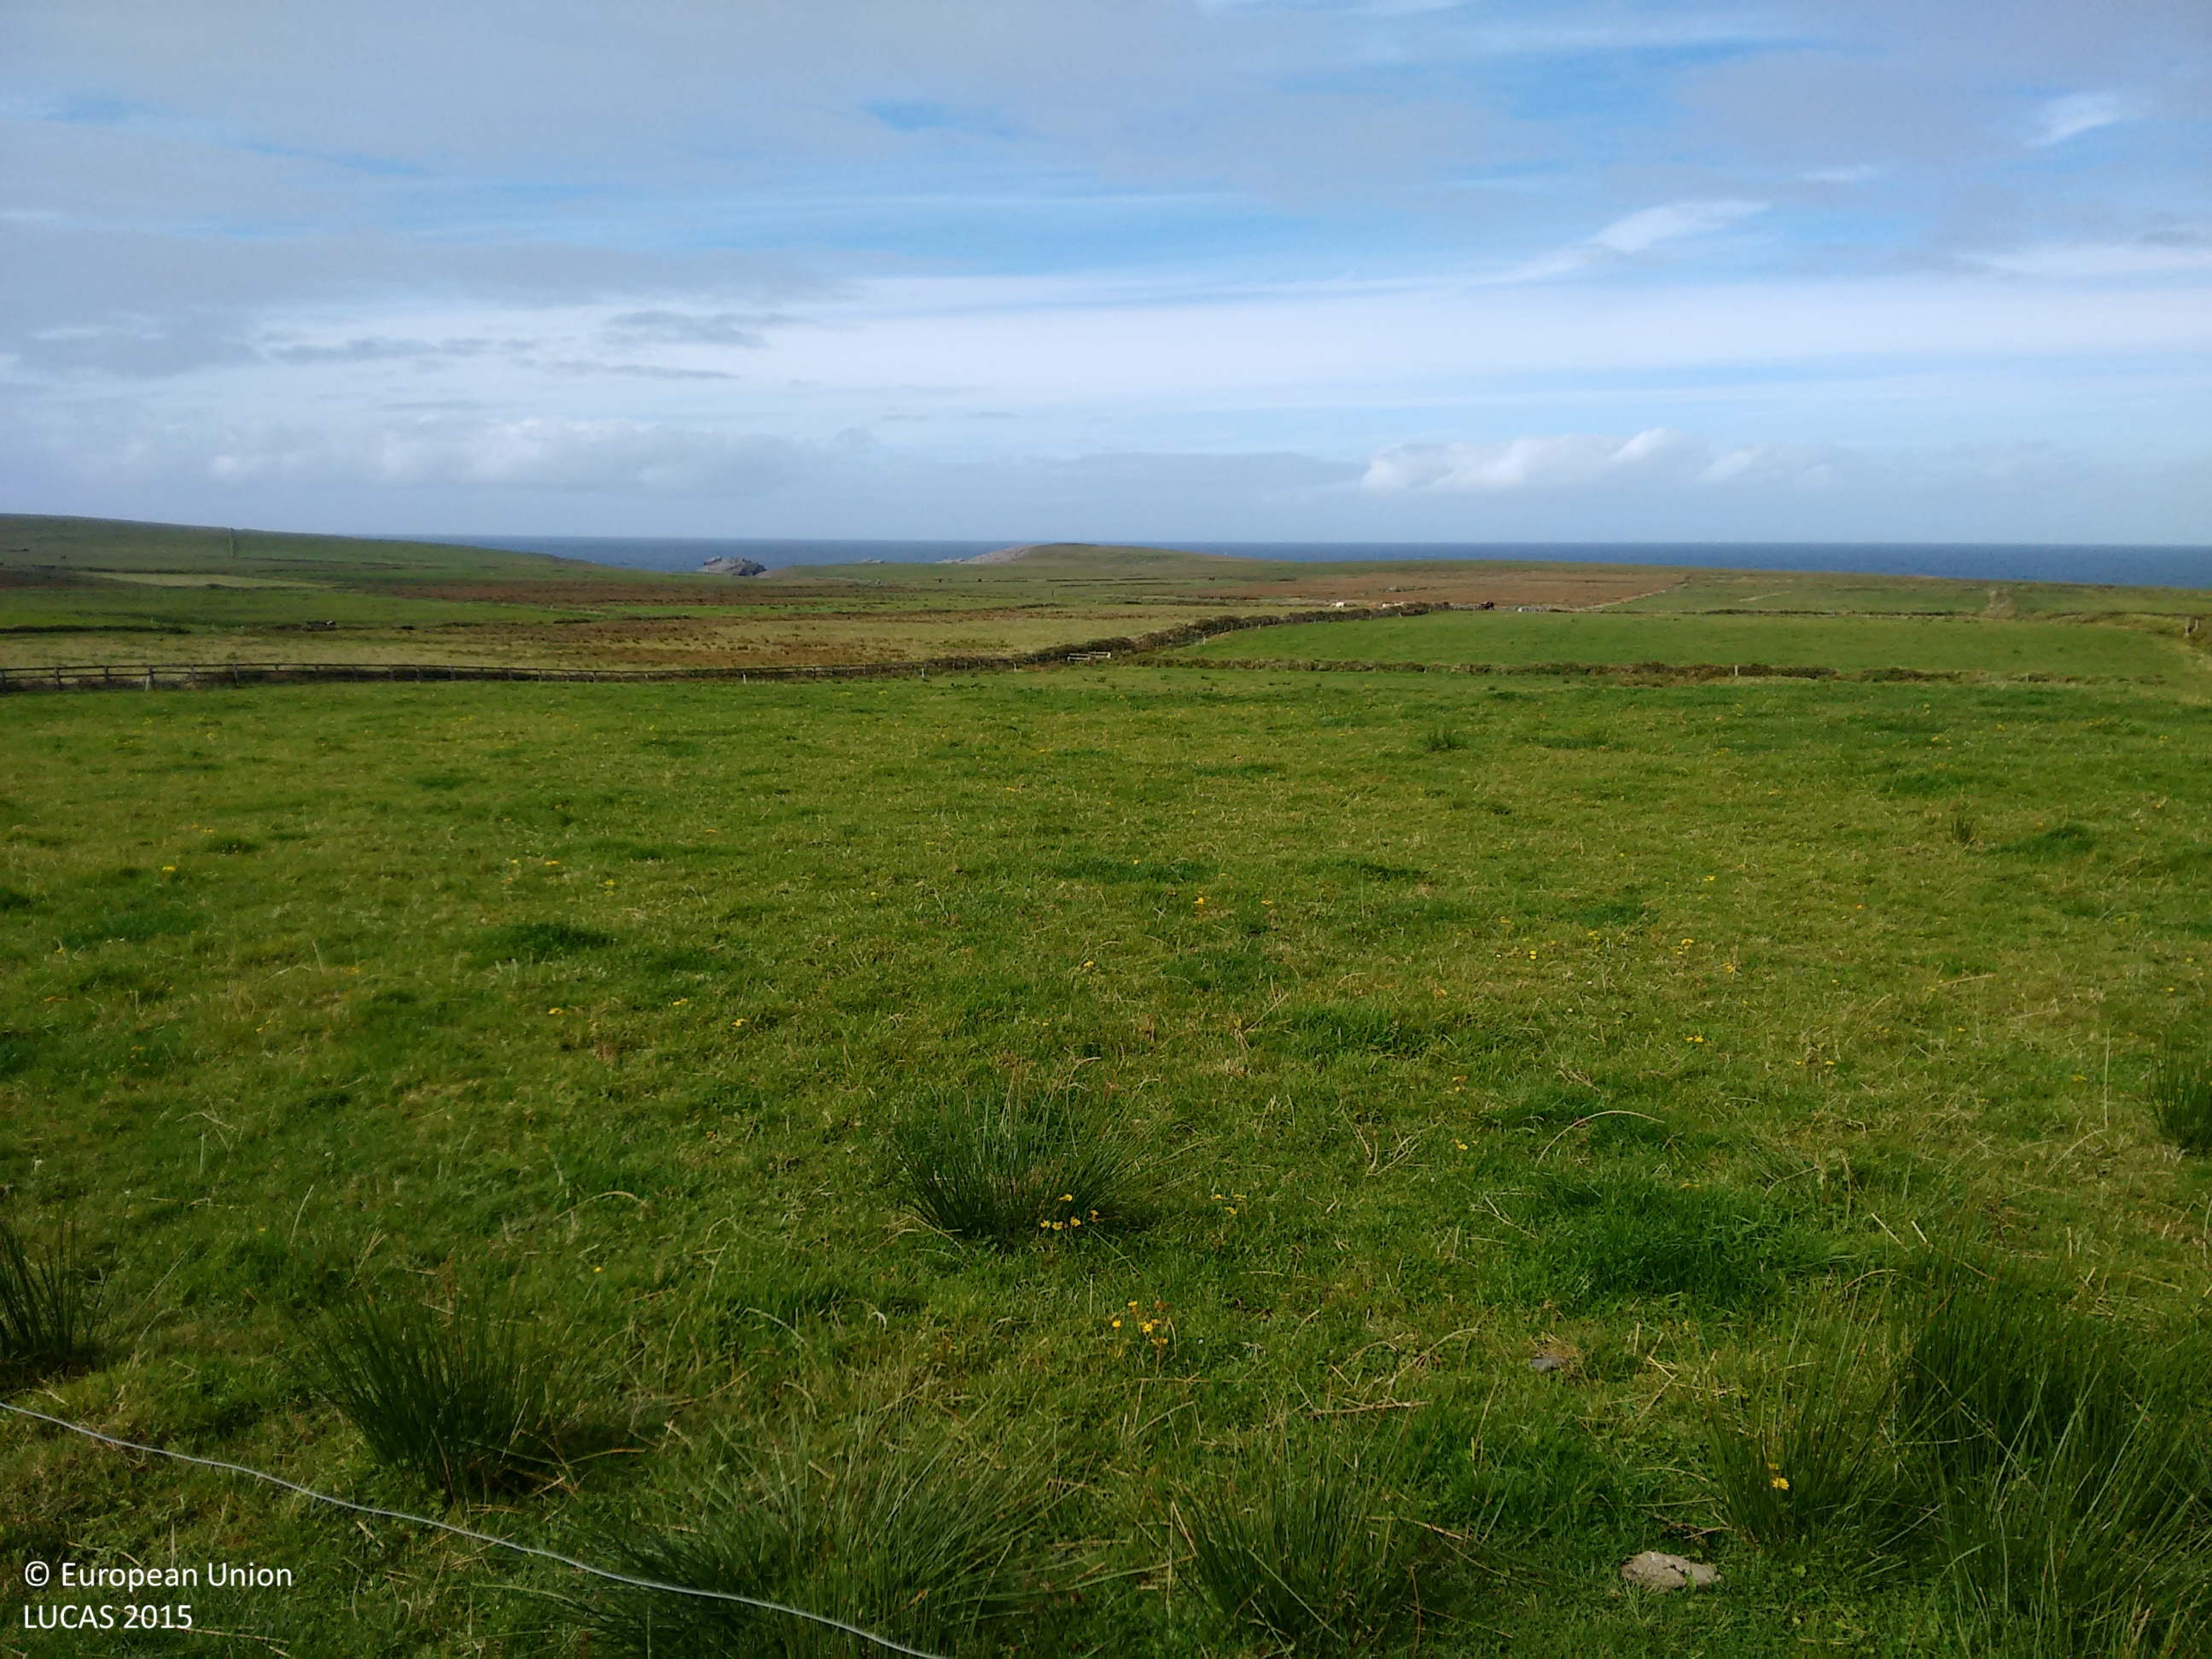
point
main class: Grassland
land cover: Grassland without tree/shrub cover
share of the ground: > 75 %
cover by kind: herbaceous plants 100 %
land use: Agriculture (excluding fallow land and kitchen gardens)
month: September
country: IE
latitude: 52.7406
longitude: -9.5962
